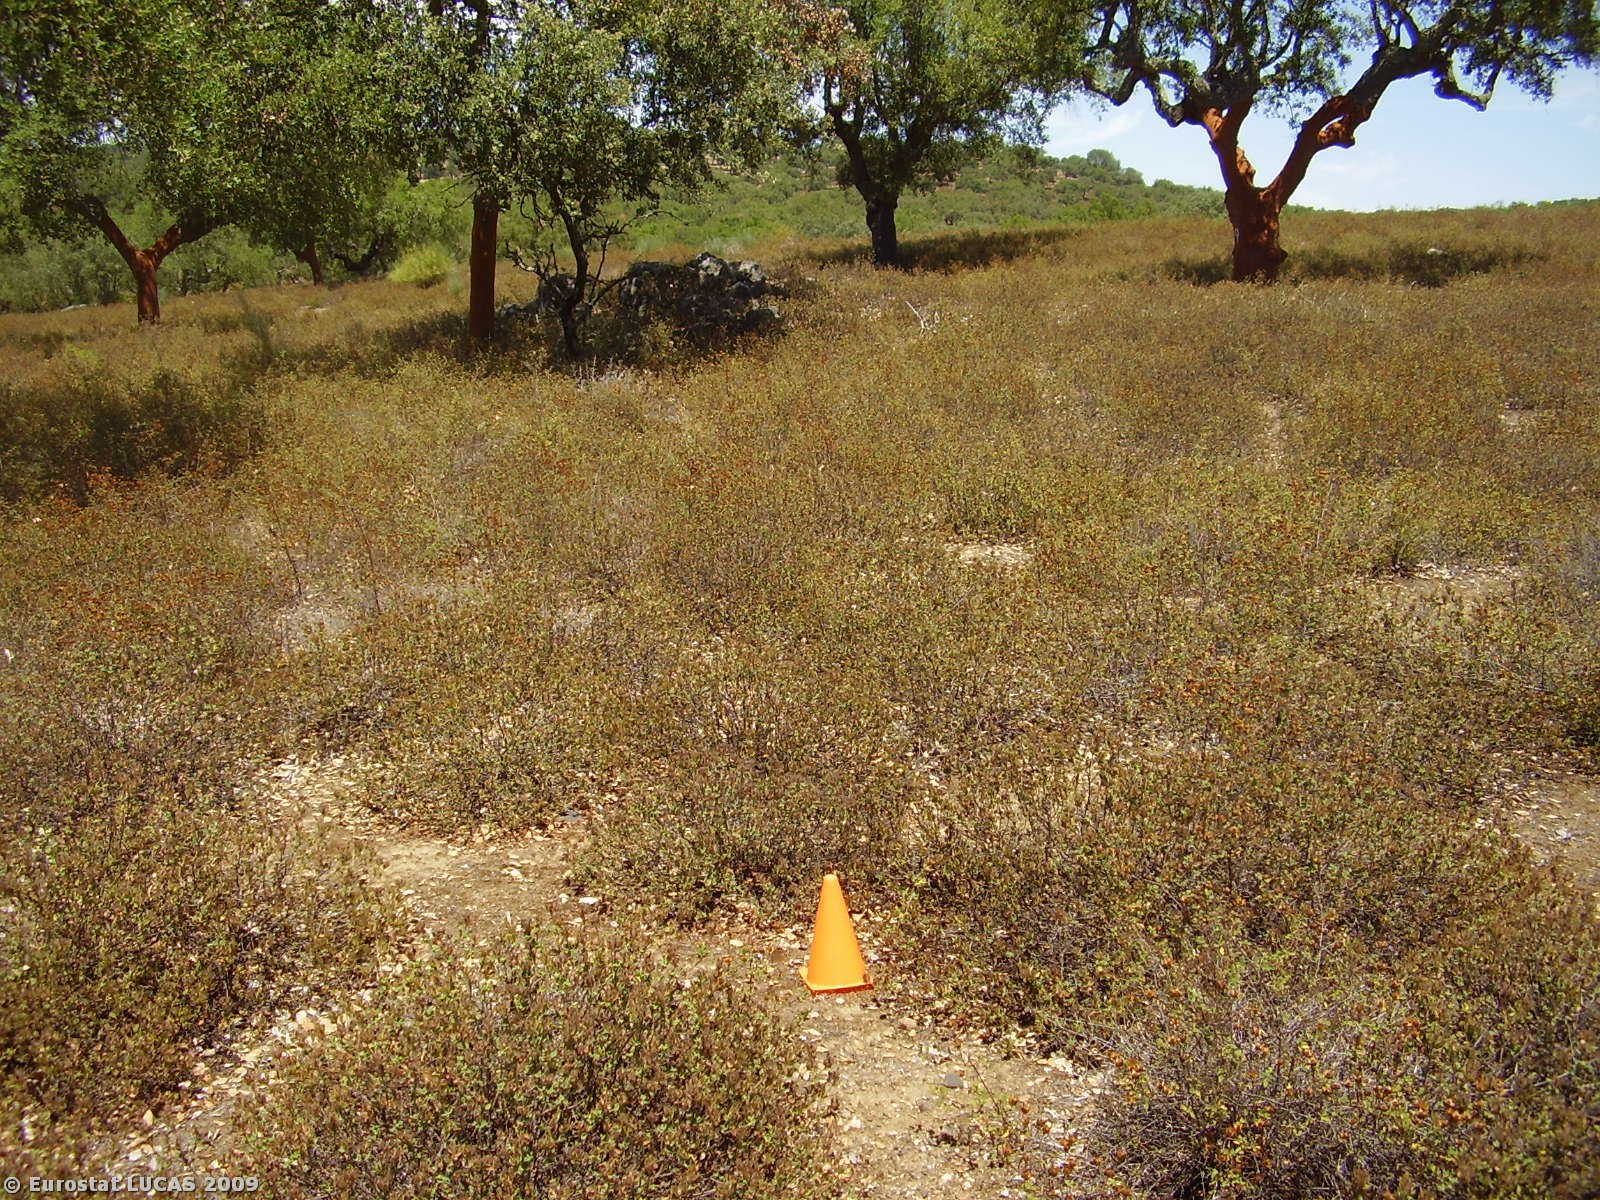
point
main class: Woodland
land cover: Broadleaved woodland
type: broadleaved evergreen forest
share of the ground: 10 - 25 %
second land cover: Spontaneously vegetated surfaces
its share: 50 - 75 %
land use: Forestry
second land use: Fallow land
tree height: > 5 m
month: July
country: PT
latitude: 38.7247
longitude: -7.8582
